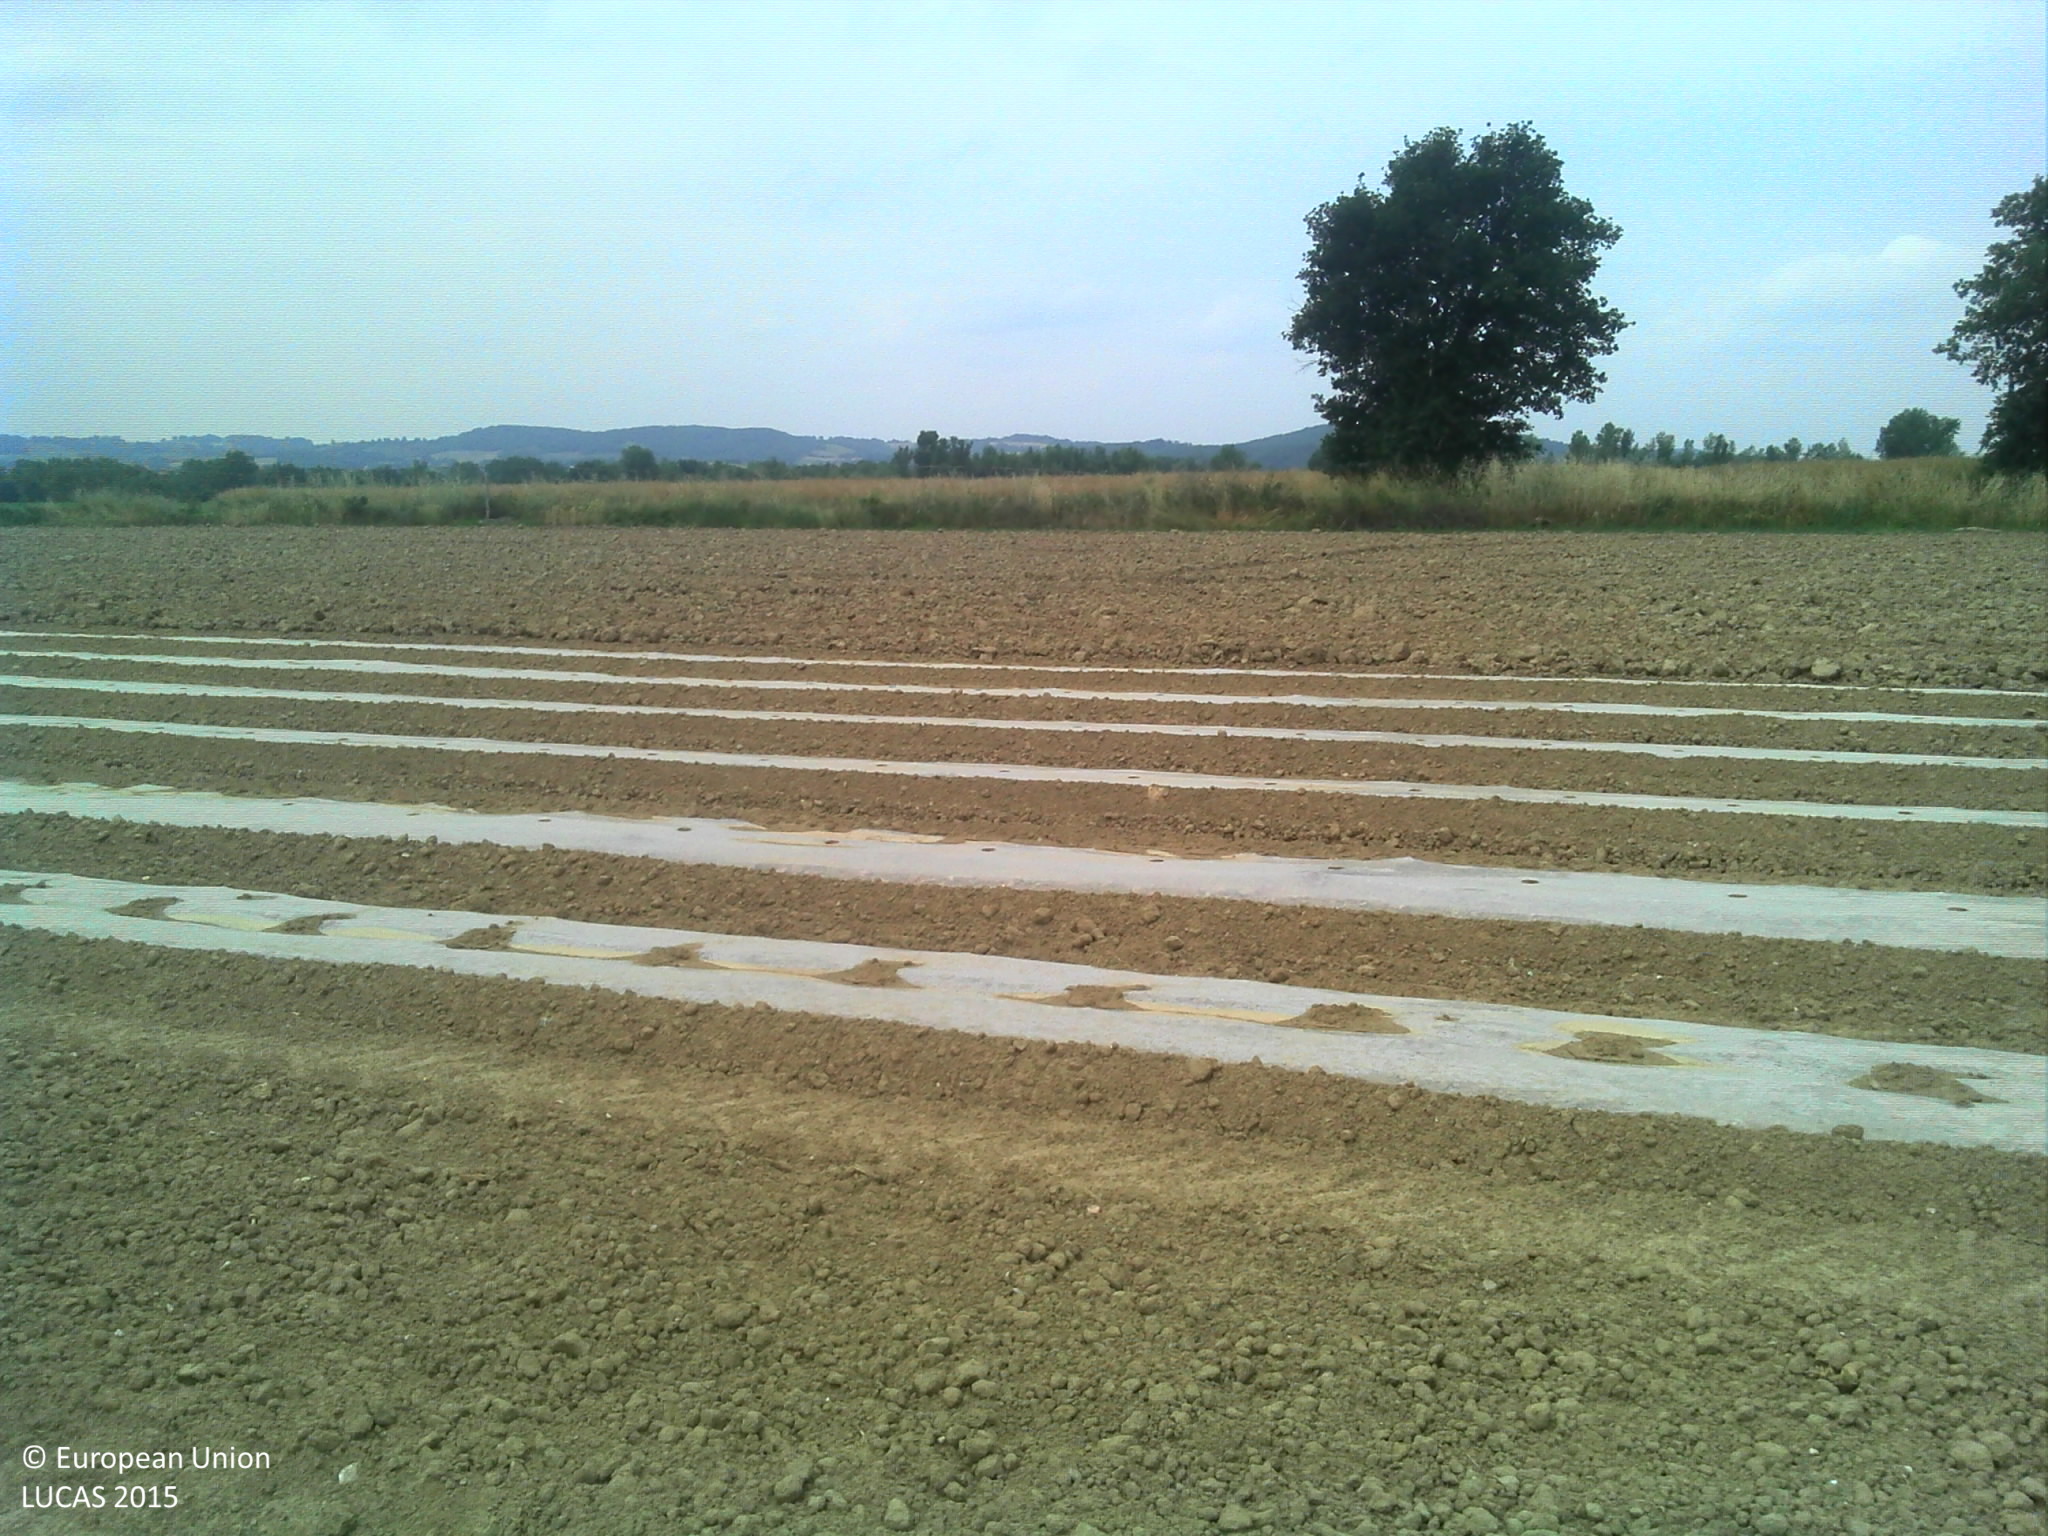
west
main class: Cropland
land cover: Other fresh vegetables
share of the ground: < 10 %
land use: Agriculture (excluding fallow land and kitchen gardens)
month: June
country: FR
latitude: 43.5991
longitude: 2.1392
